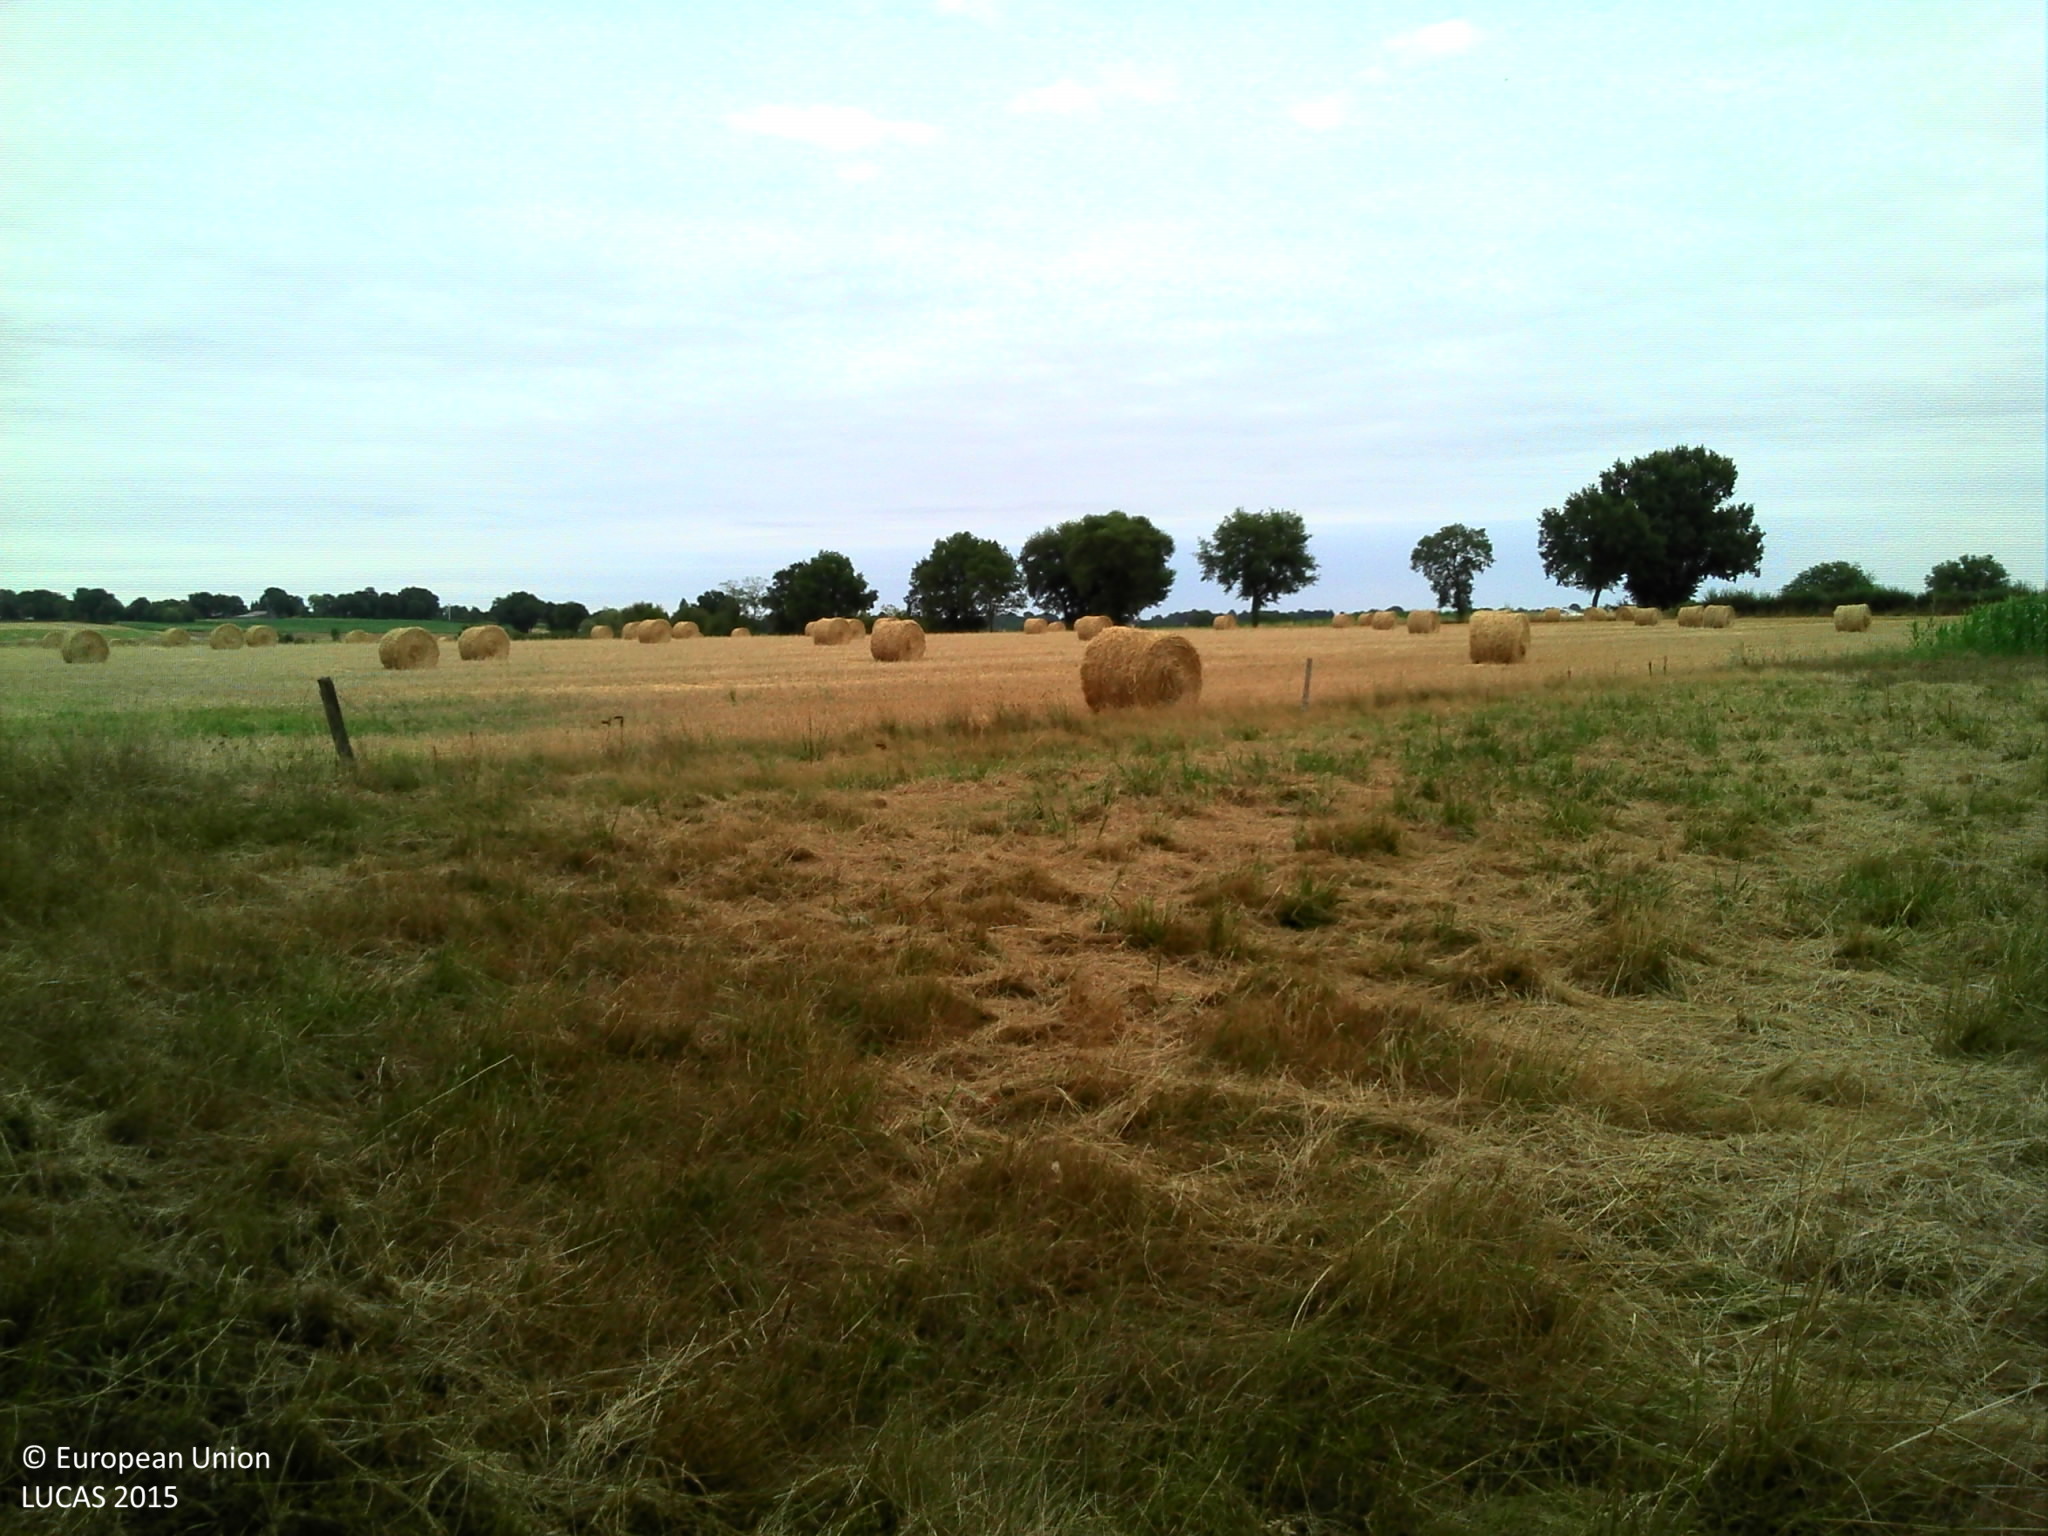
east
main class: Grassland
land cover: Grassland without tree/shrub cover
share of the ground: > 75 %
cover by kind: herbaceous plants 100 %
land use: Agriculture (excluding fallow land and kitchen gardens)
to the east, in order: Grassland without tree/shrub cover; Broadleaved woodland; Fences; Grassland without tree/shrub cover; Fences; Triticale
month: July
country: FR
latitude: 46.3322
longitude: 0.5658
